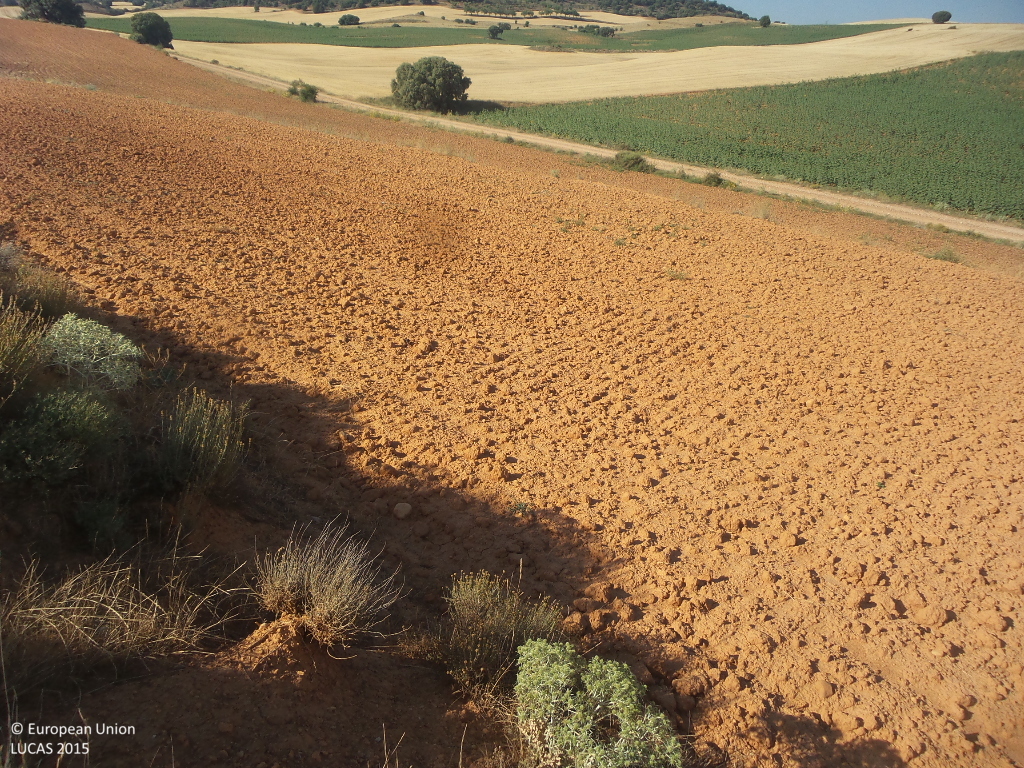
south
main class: Shrubland
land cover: Shrubland without tree cover
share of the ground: 50 - 75 %
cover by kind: shrubs 50 %, unconsolidated bare surface 40 %, herbaceous plants 10 %
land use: Semi-natural and natural areas not in use
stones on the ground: < 10 %
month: July
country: ES
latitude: 41.2036
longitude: -2.0362
